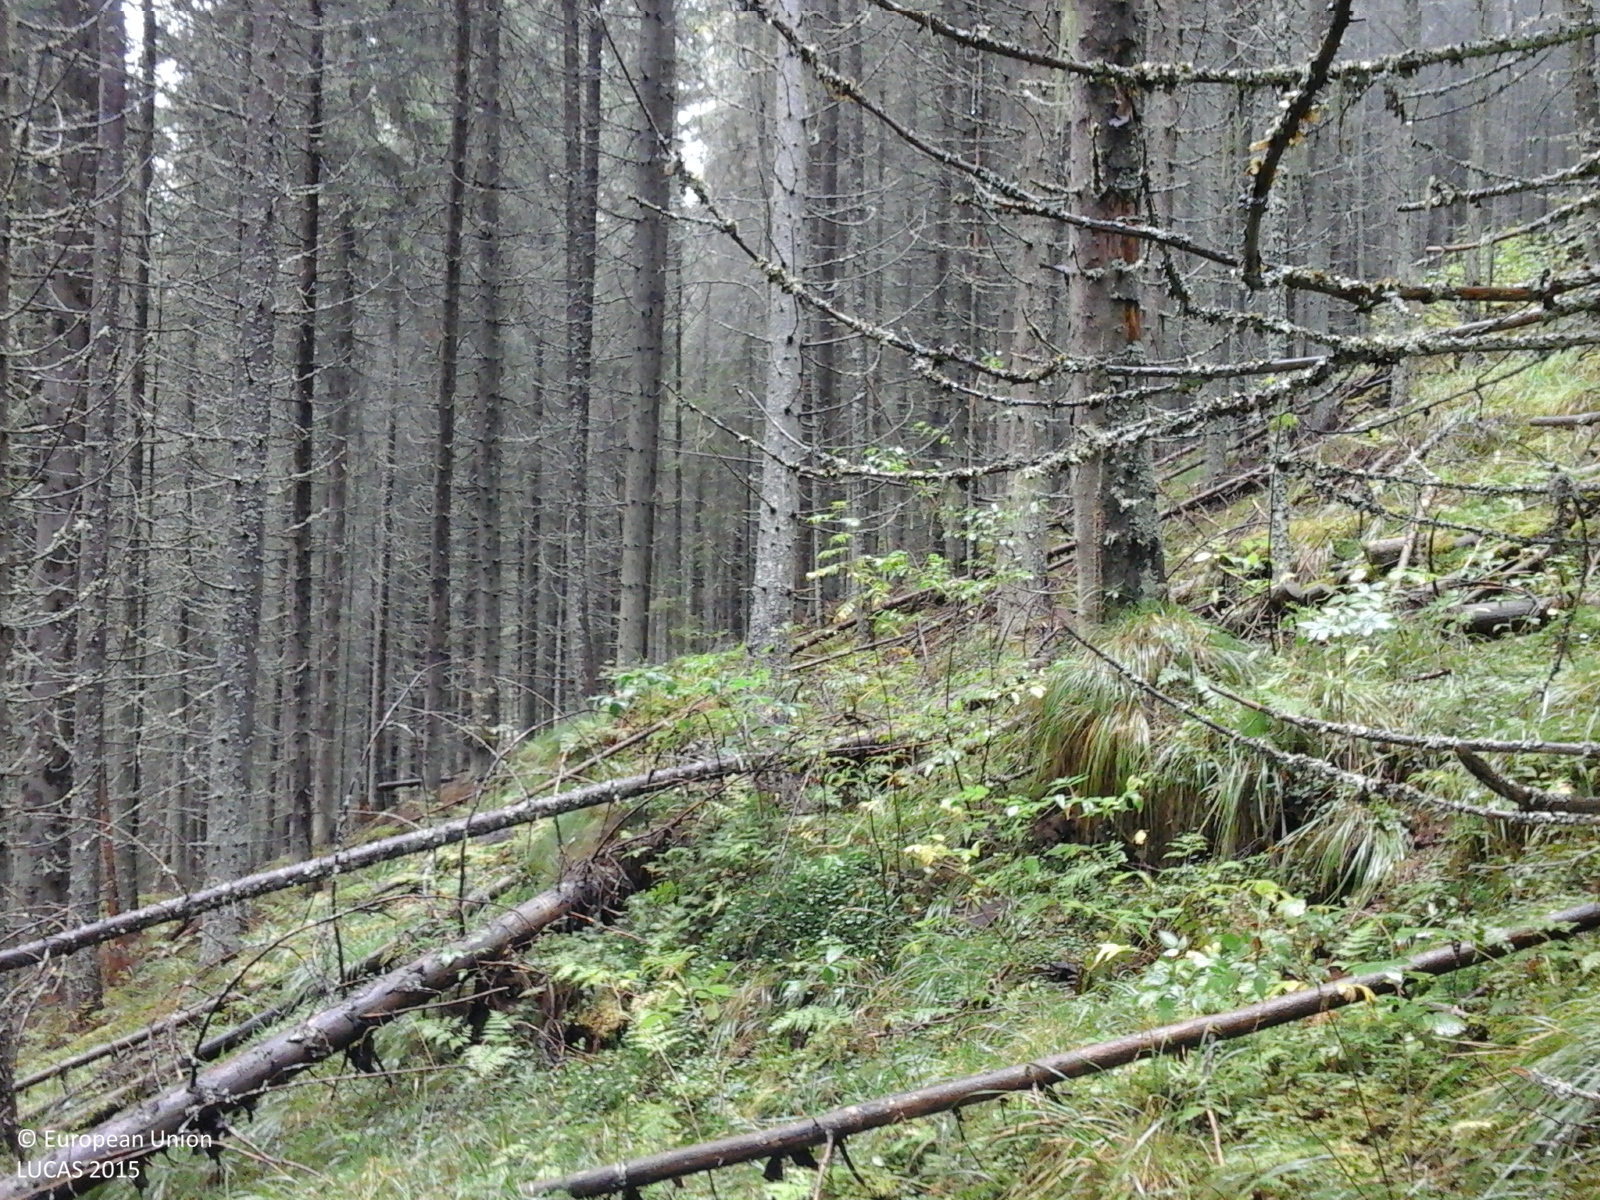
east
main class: Woodland
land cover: Spruce dominated coniferous woodland
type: alpine coniferous forest
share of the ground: > 75 %
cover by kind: coniferous forest trees 100 %
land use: Forestry
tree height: > 5 m
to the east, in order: Spruce dominated coniferous woodland
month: September
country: RO
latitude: 45.5969
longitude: 23.6662
